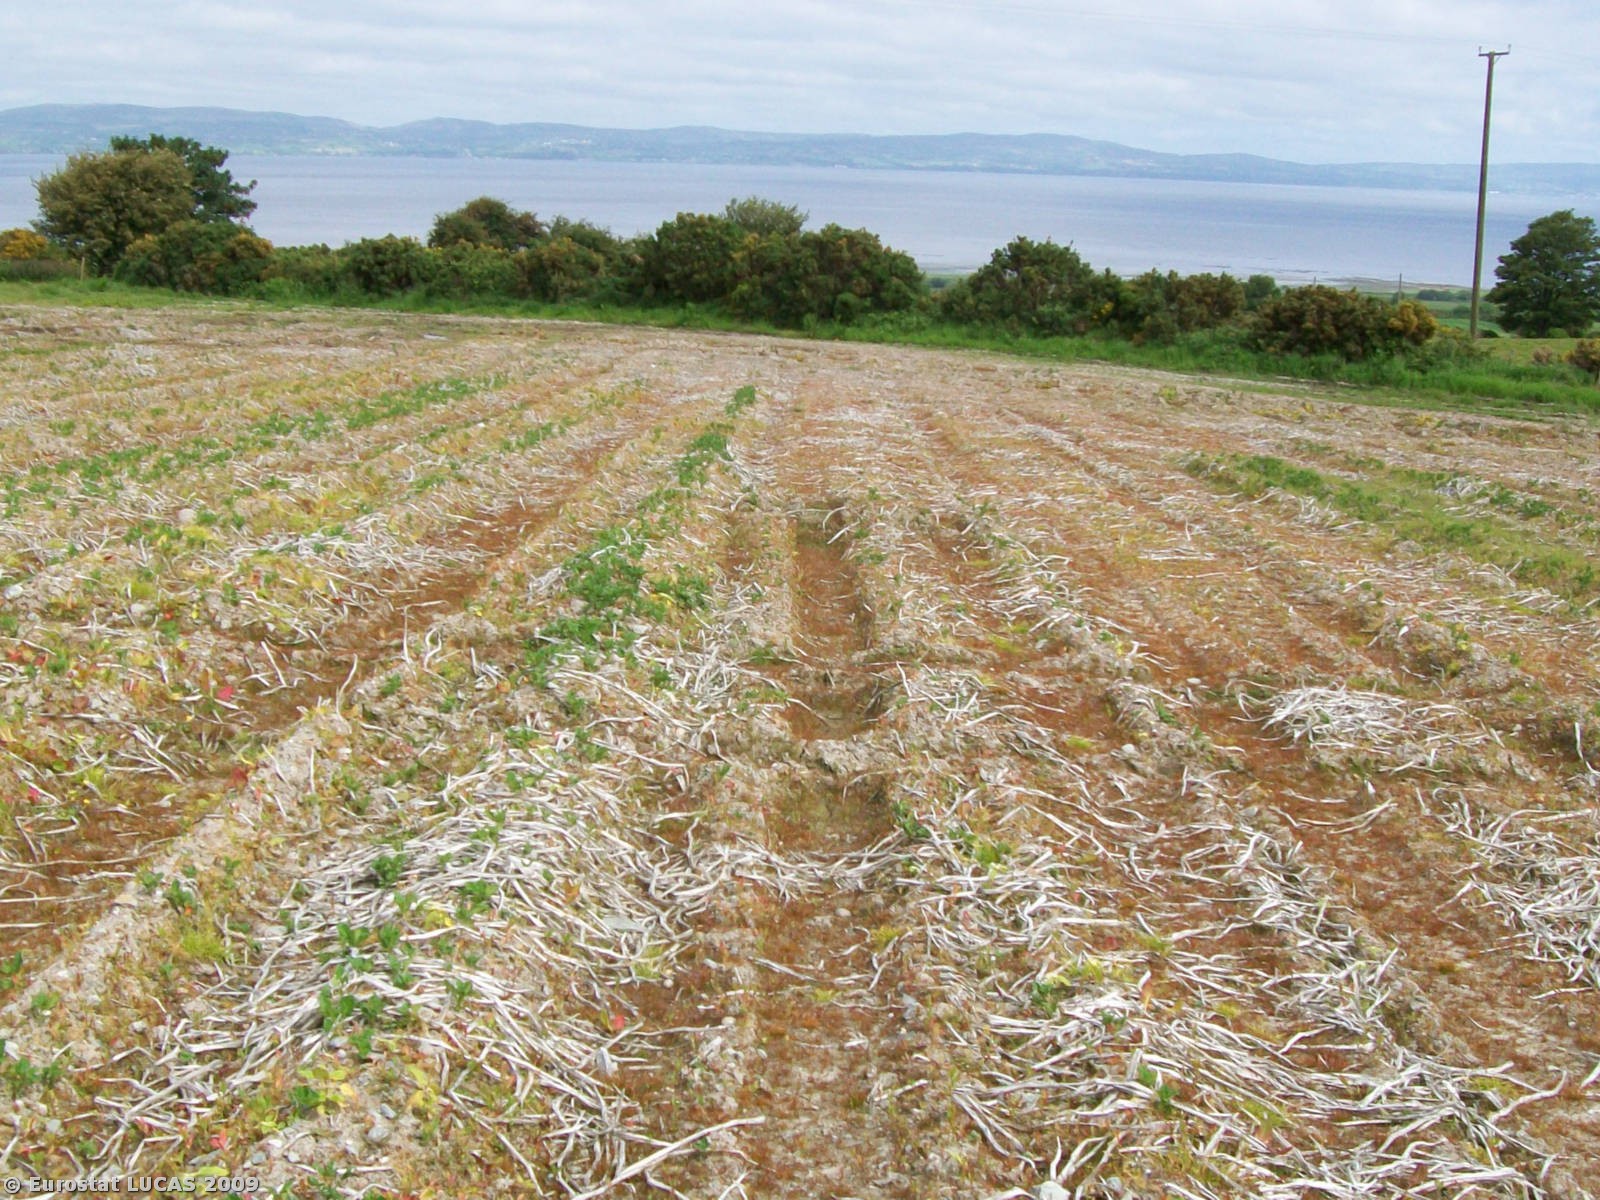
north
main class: Cropland
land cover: Potatoes
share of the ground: > 75 %
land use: Agriculture (excluding fallow land and kitchen gardens)
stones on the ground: < 10 %
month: June
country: GB
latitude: 55.0289
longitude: -7.0831
